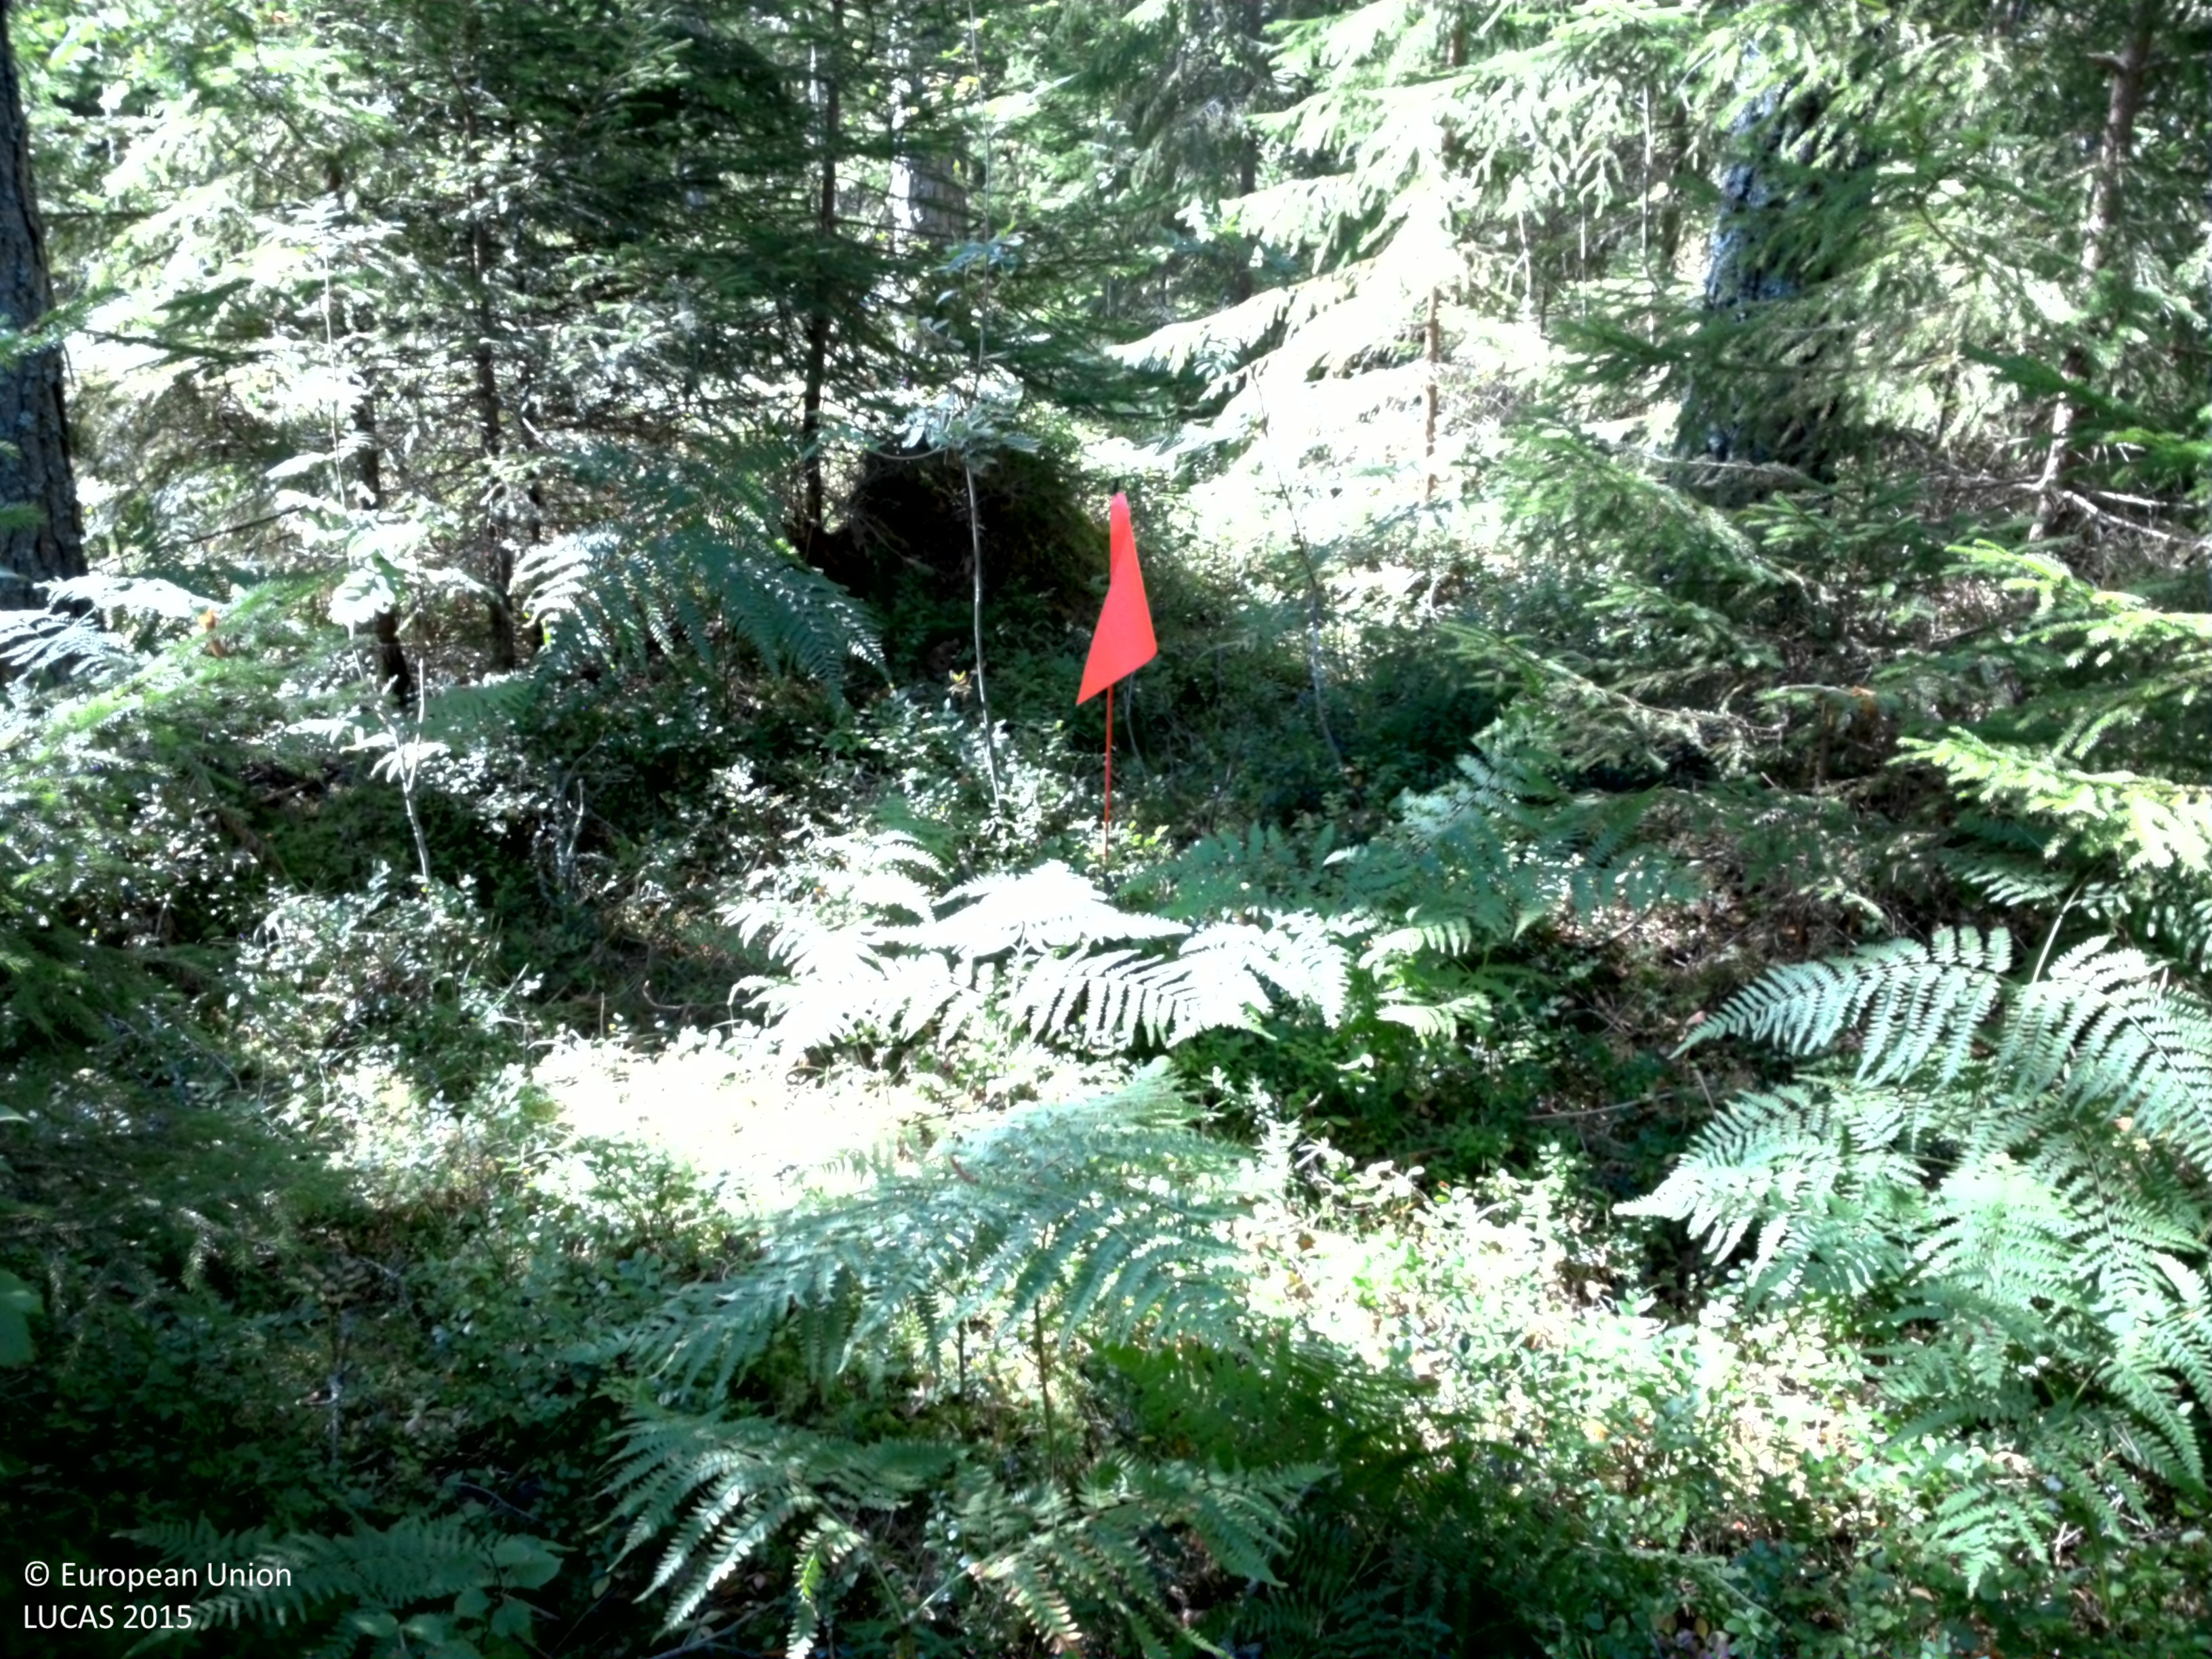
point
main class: Woodland
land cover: Other coniferous woodland
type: boreal forest
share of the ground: > 75 %
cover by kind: coniferous forest trees 75 %, shrubs 15 %, broadleaved forest trees 5 %, herbaceous plants 5 %
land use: Forestry
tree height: > 5 m
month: August
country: SE
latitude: 60.0782
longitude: 17.0187
